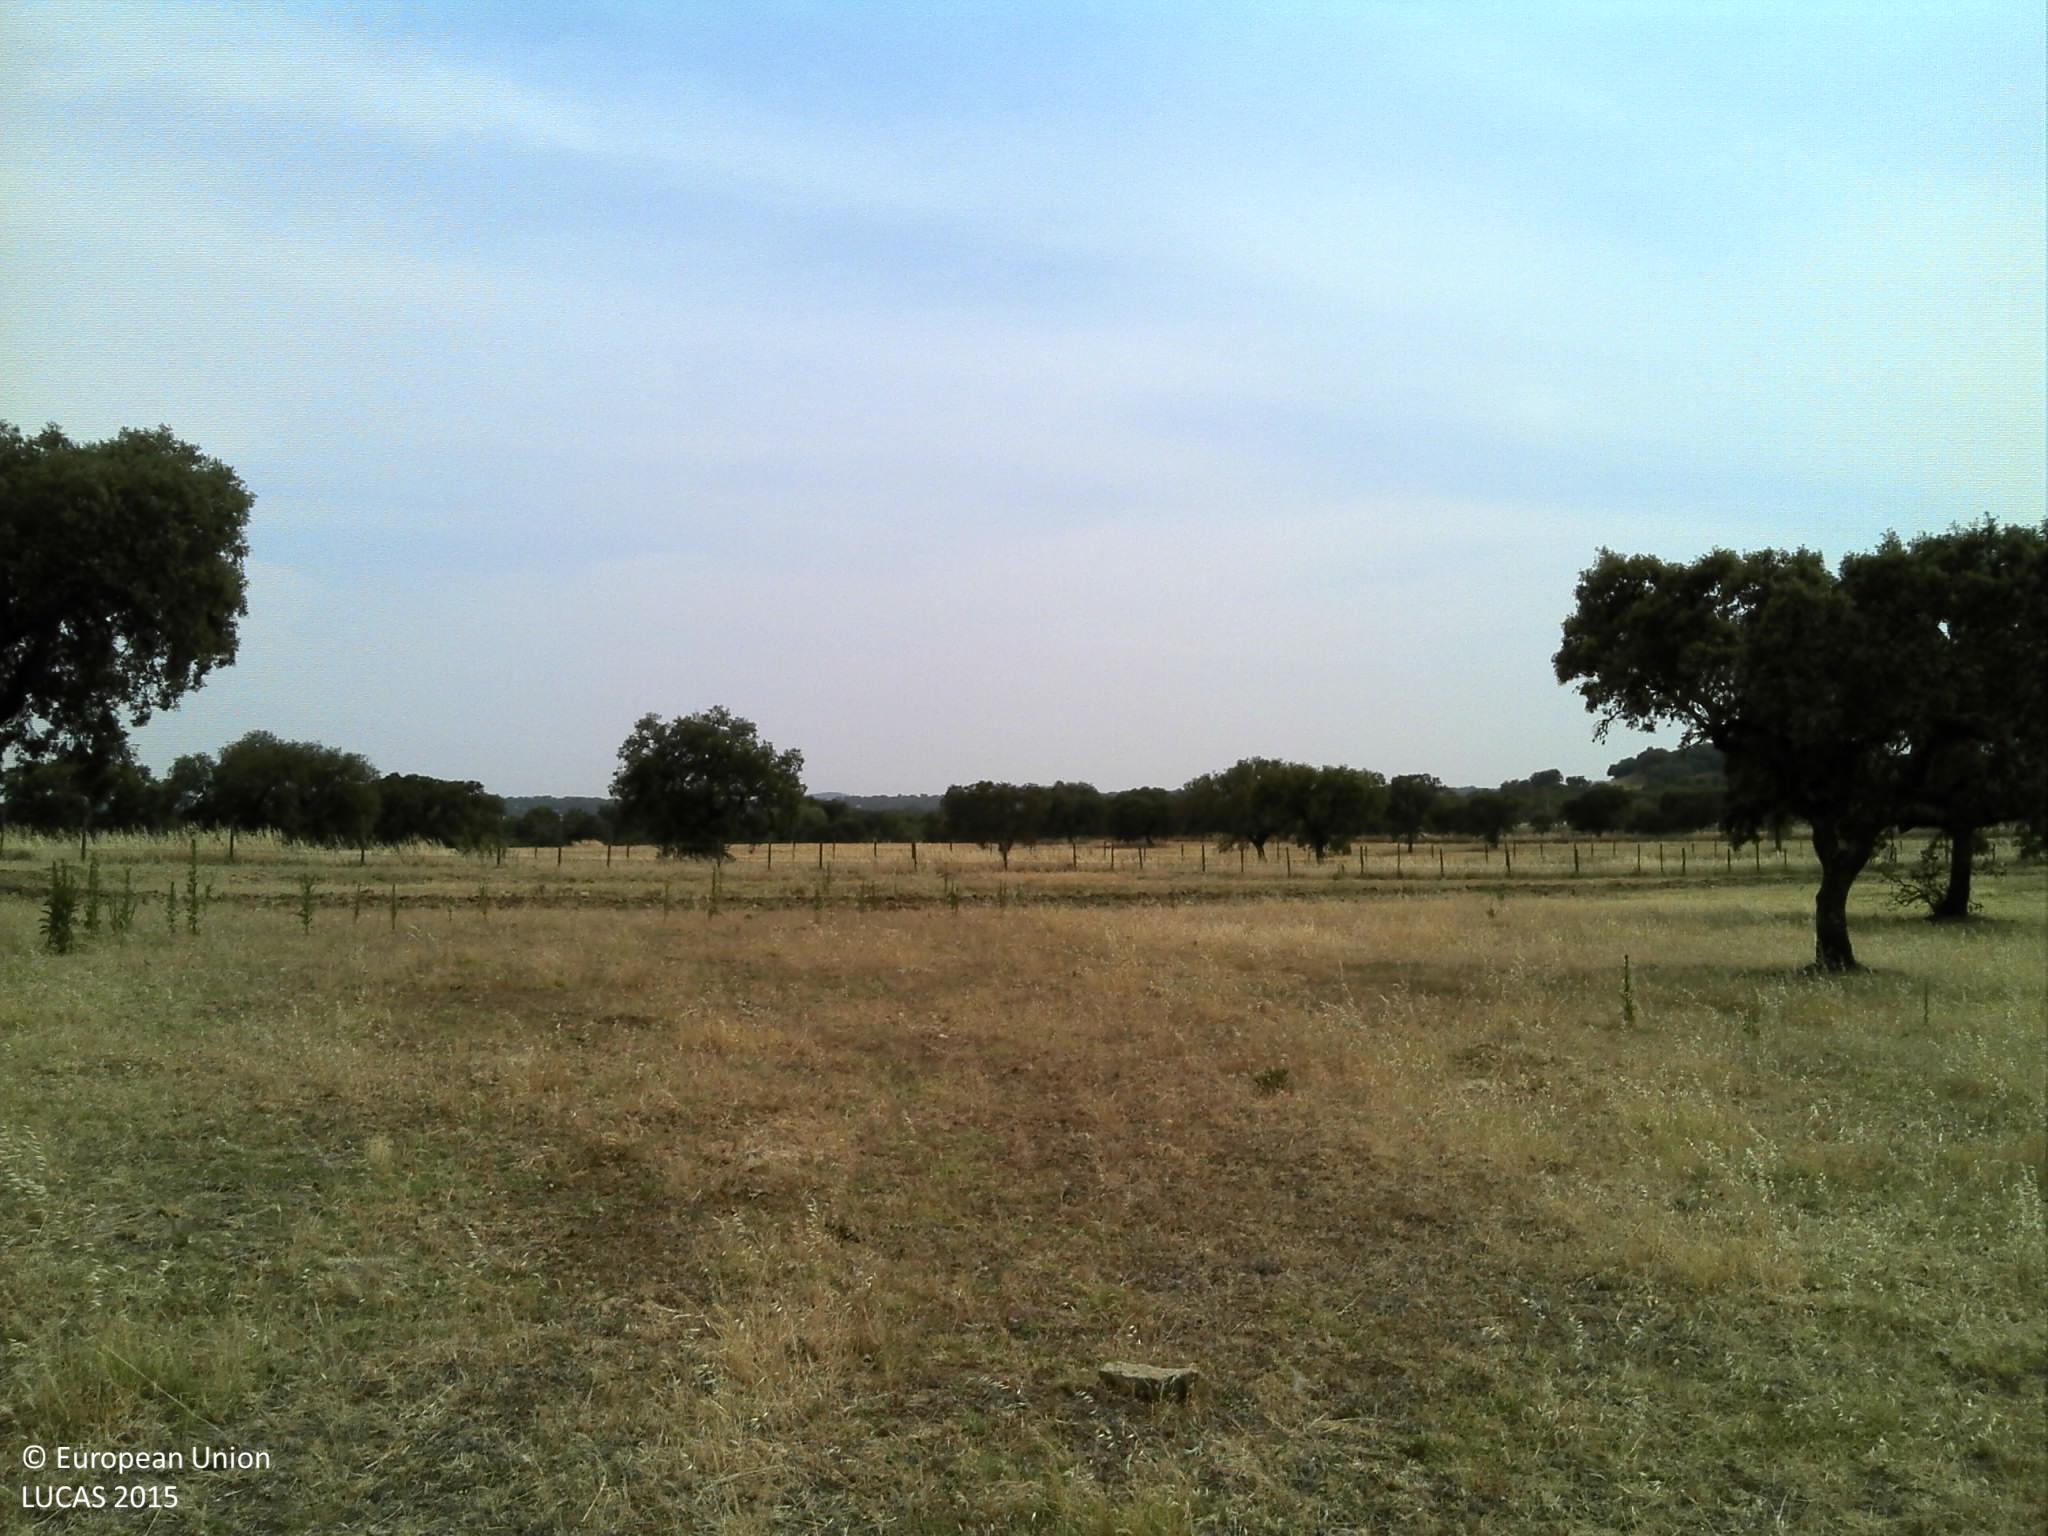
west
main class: Grassland
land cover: Grassland without tree/shrub cover
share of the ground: 25 - 50 %
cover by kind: unconsolidated bare surface 65 %, herbaceous plants 35 %
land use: Agriculture (excluding fallow land and kitchen gardens)
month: June
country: PT
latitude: 38.4216
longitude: -7.7991
